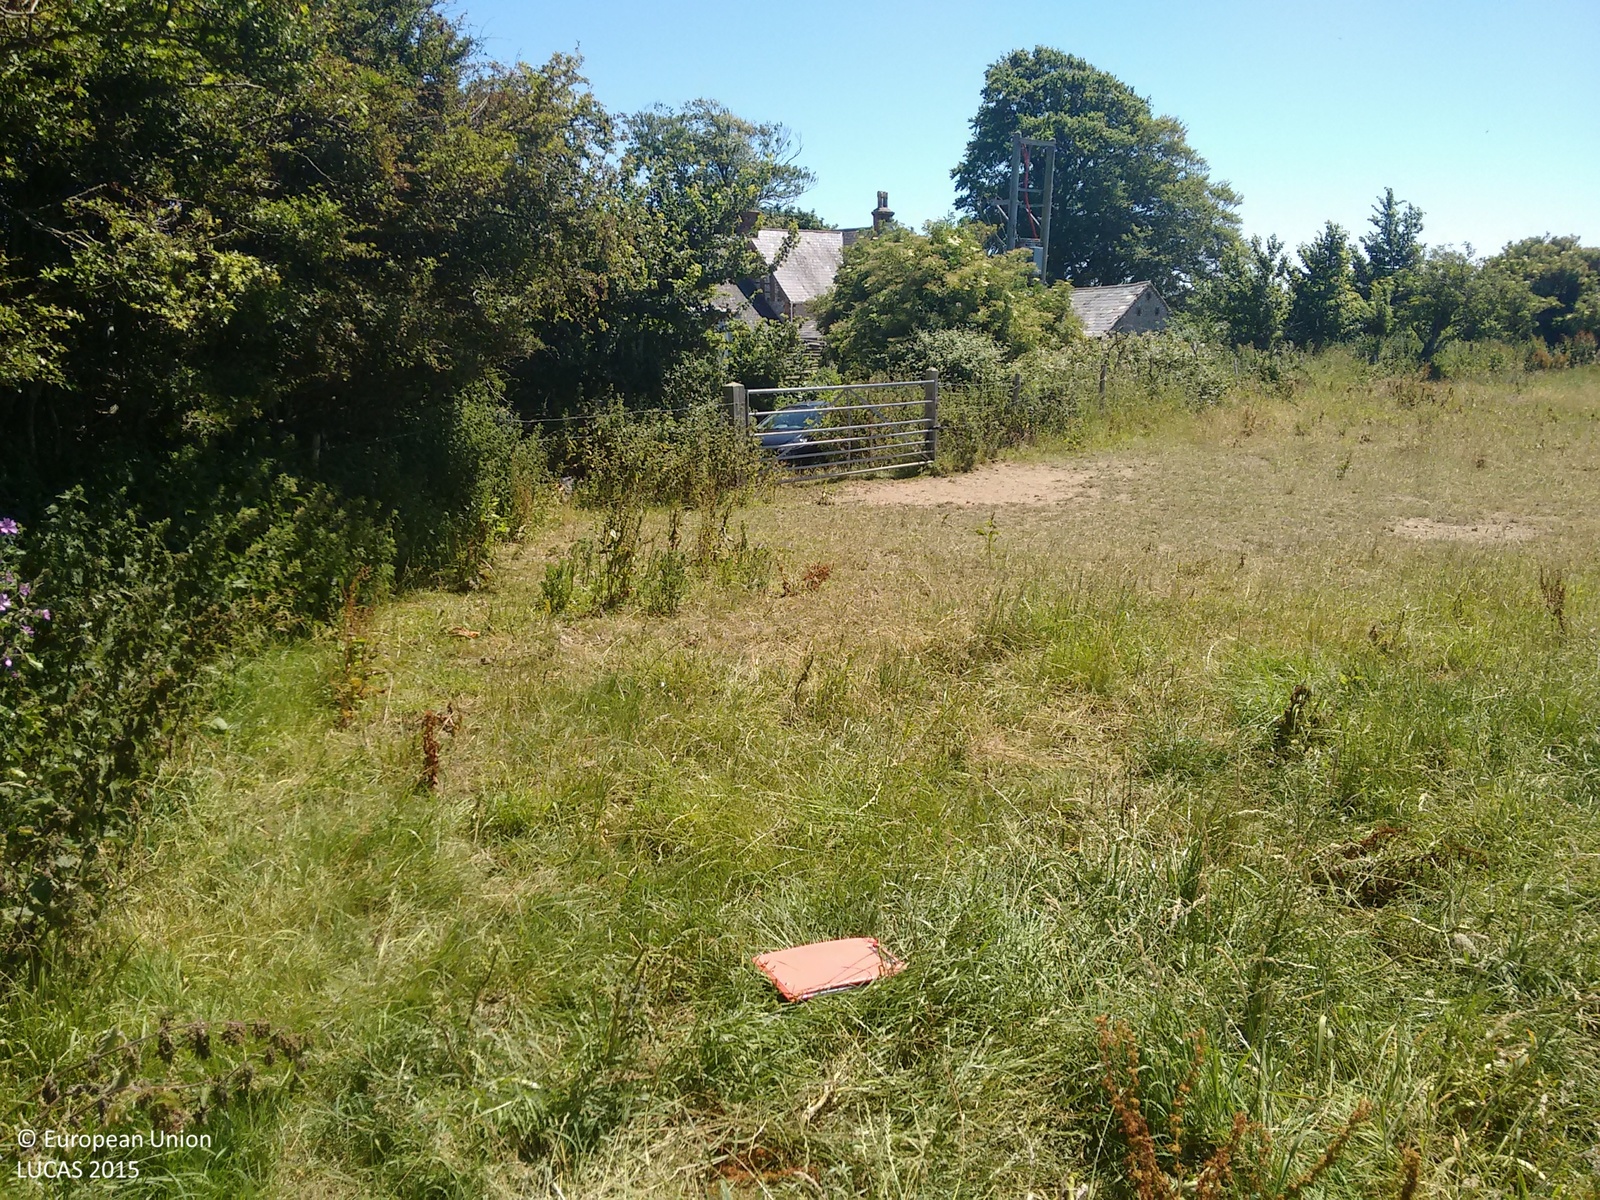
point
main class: Grassland
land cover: Grassland without tree/shrub cover
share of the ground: > 75 %
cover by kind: herbaceous plants 100 %
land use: Agriculture (excluding fallow land and kitchen gardens)
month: June
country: GB
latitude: 50.8352
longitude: -0.3595
